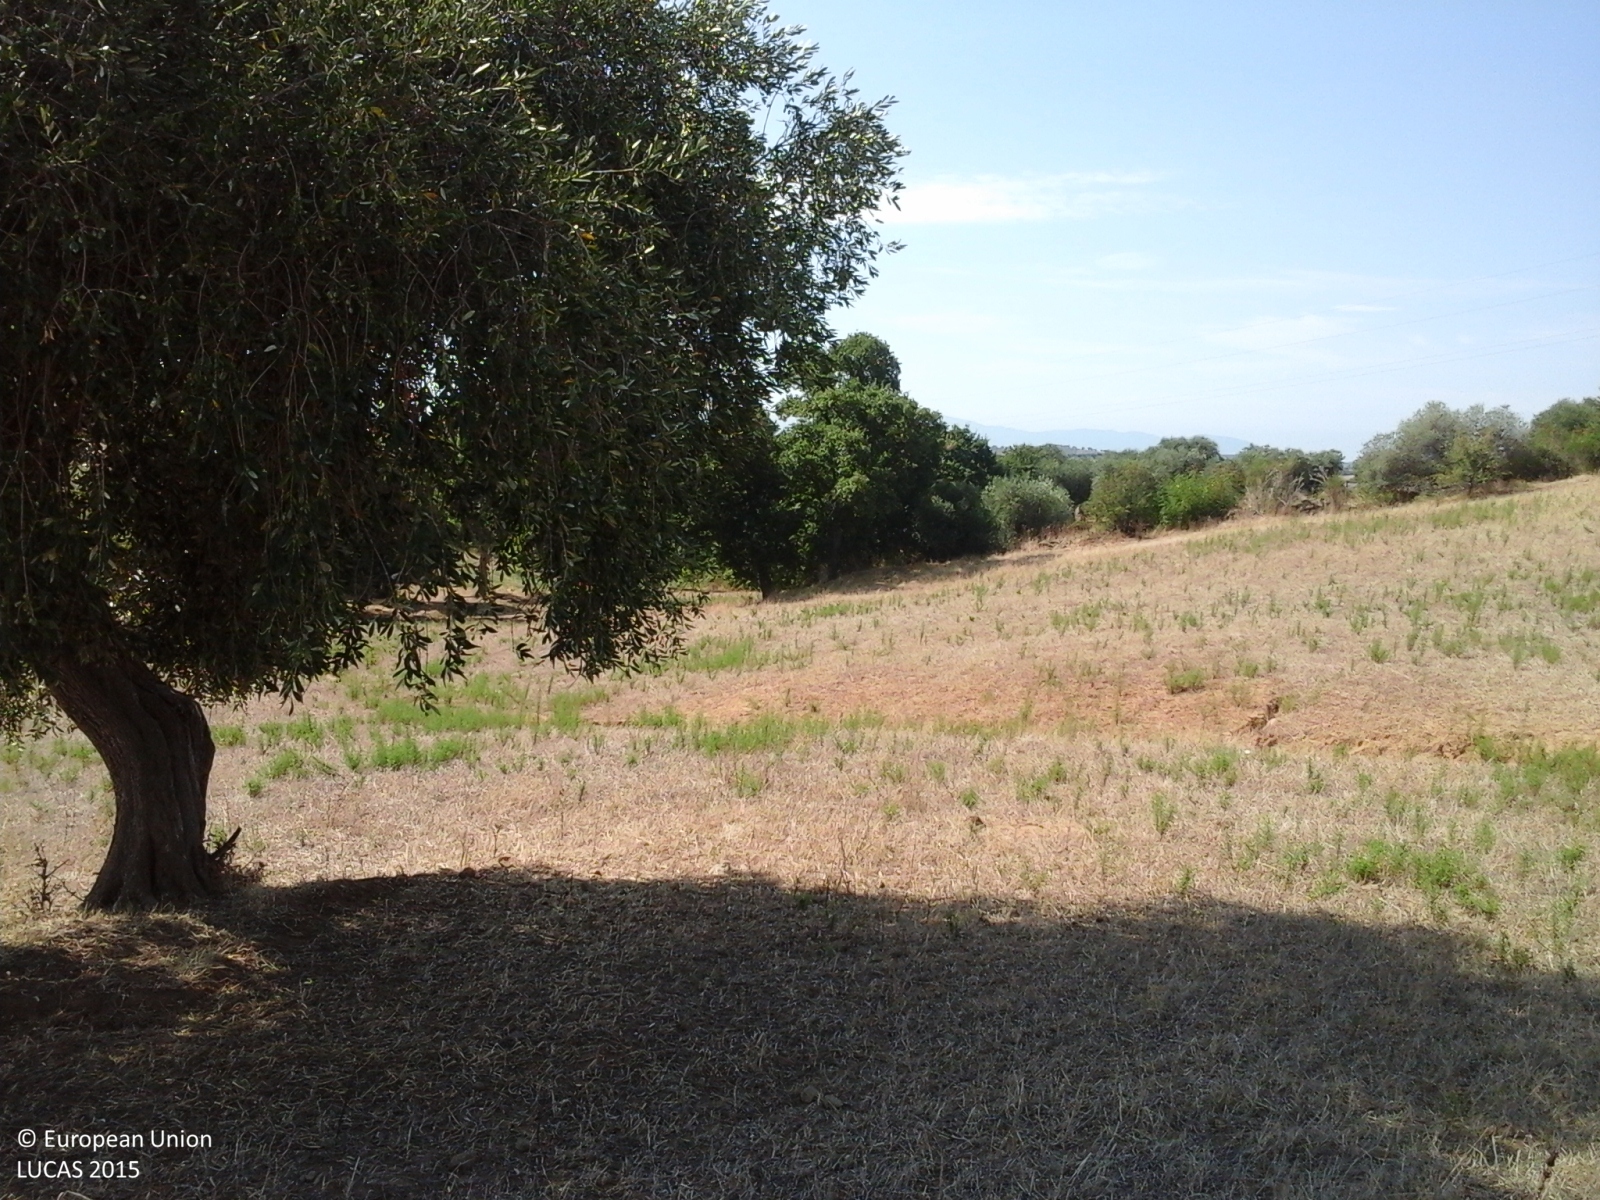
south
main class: Cropland
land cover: Temporary grasslands
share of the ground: > 75 %
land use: Agriculture (excluding fallow land and kitchen gardens)
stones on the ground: < 10 %
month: August
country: IT
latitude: 42.6285
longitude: 11.2274
